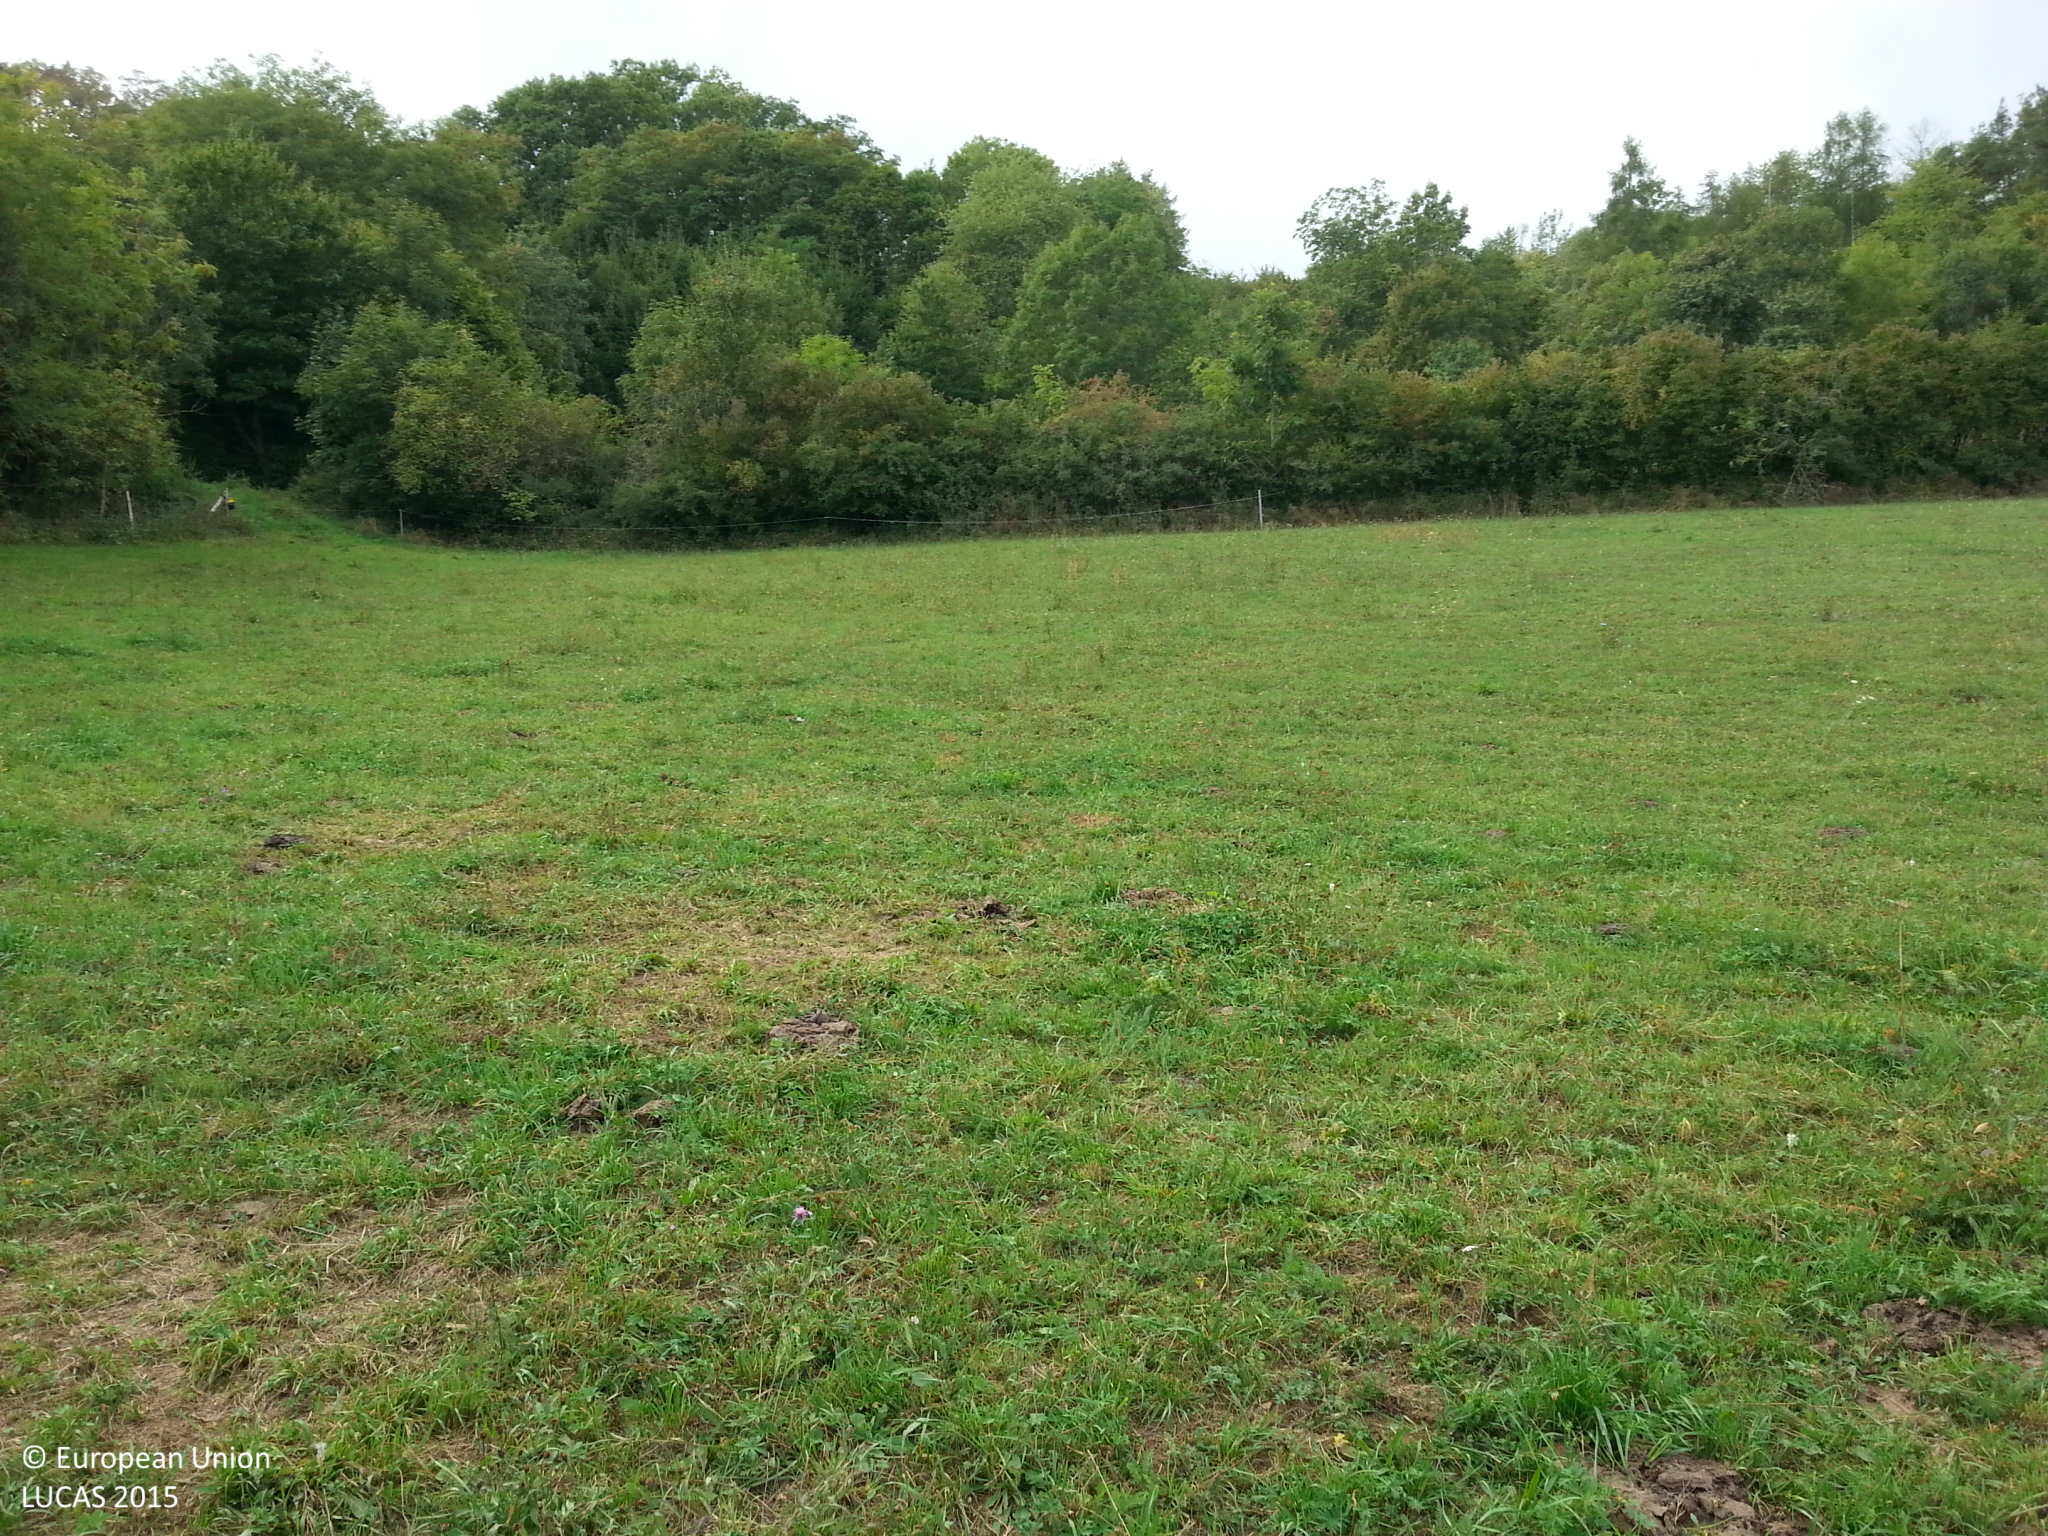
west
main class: Grassland
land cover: Grassland without tree/shrub cover
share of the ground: > 75 %
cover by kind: herbaceous plants 100 %
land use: Agriculture (excluding fallow land and kitchen gardens)
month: September
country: DE
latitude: 49.3929
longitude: 9.9036
